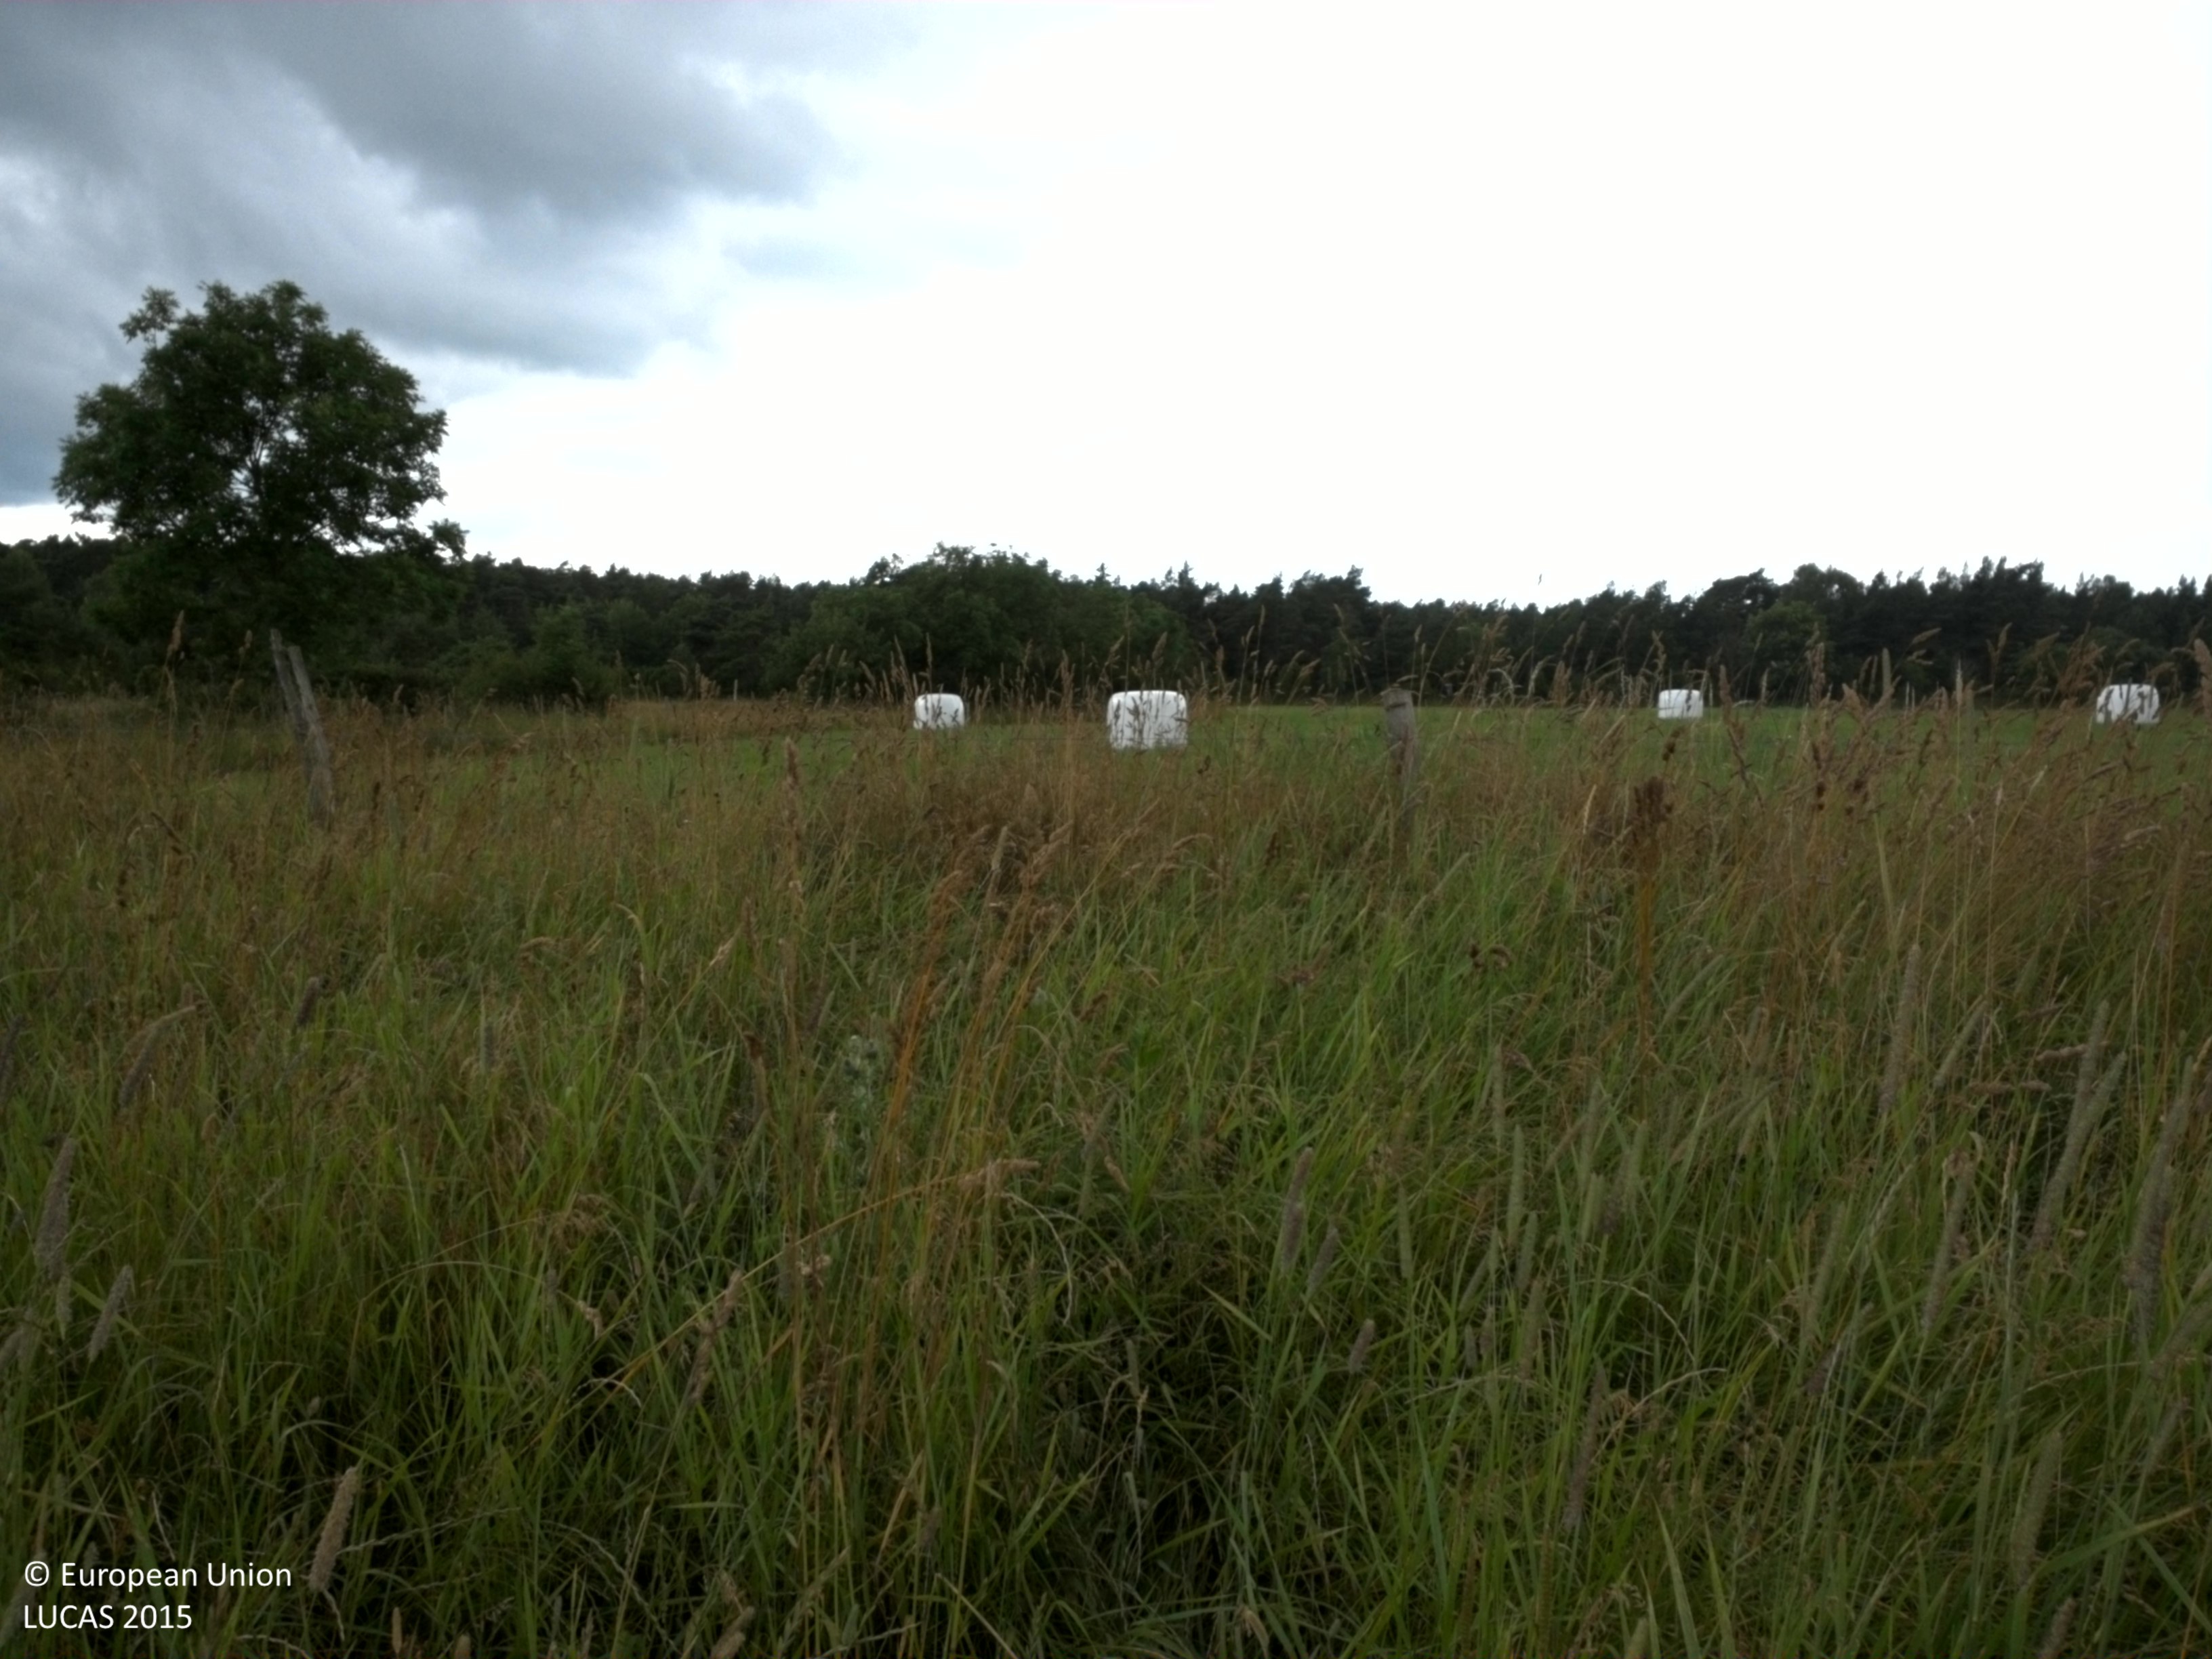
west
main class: Grassland
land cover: Grassland without tree/shrub cover
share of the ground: > 75 %
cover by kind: herbaceous plants 95 %, shrubs 5 %
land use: Agriculture (excluding fallow land and kitchen gardens)
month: July
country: SE
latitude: 57.5101
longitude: 18.3032
